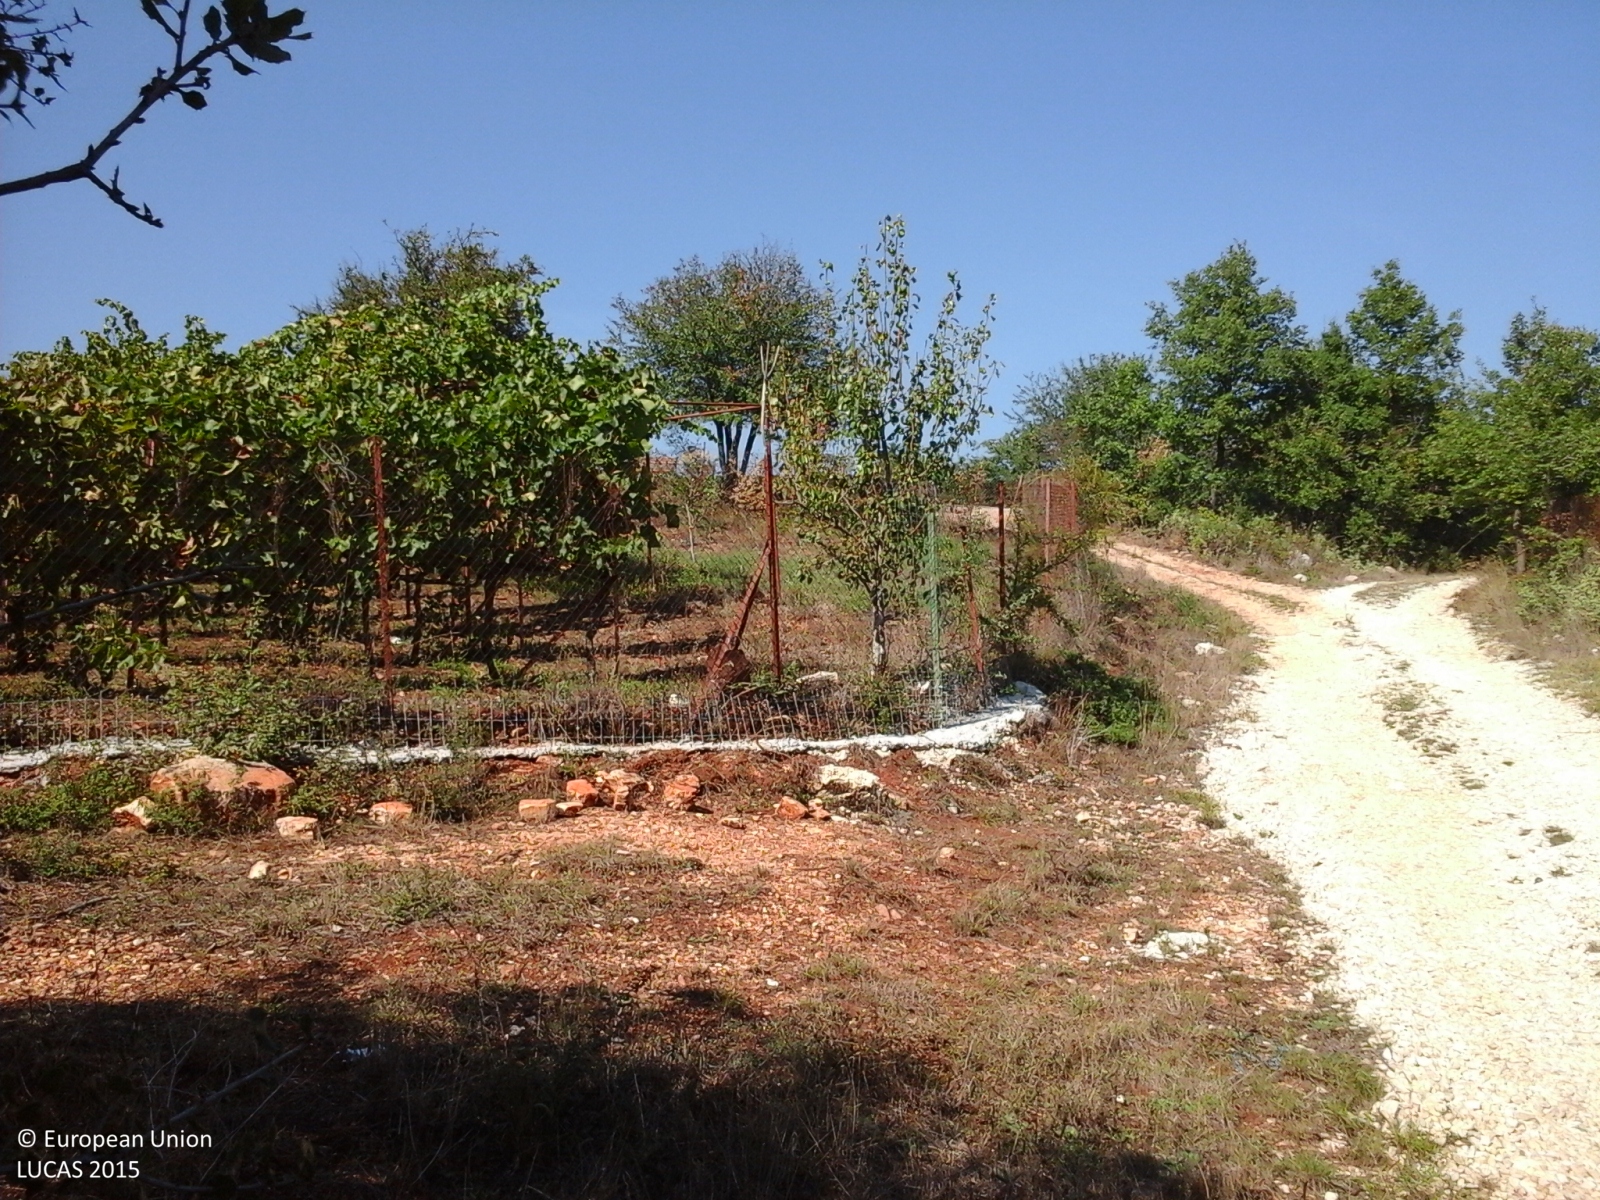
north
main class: Cropland
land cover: Vineyards
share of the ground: 50 - 75 %
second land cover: Spontaneously vegetated surfaces
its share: 50 - 75 %
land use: Agriculture (excluding fallow land and kitchen gardens)
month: September
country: GR
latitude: 39.7426
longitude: 20.6324
